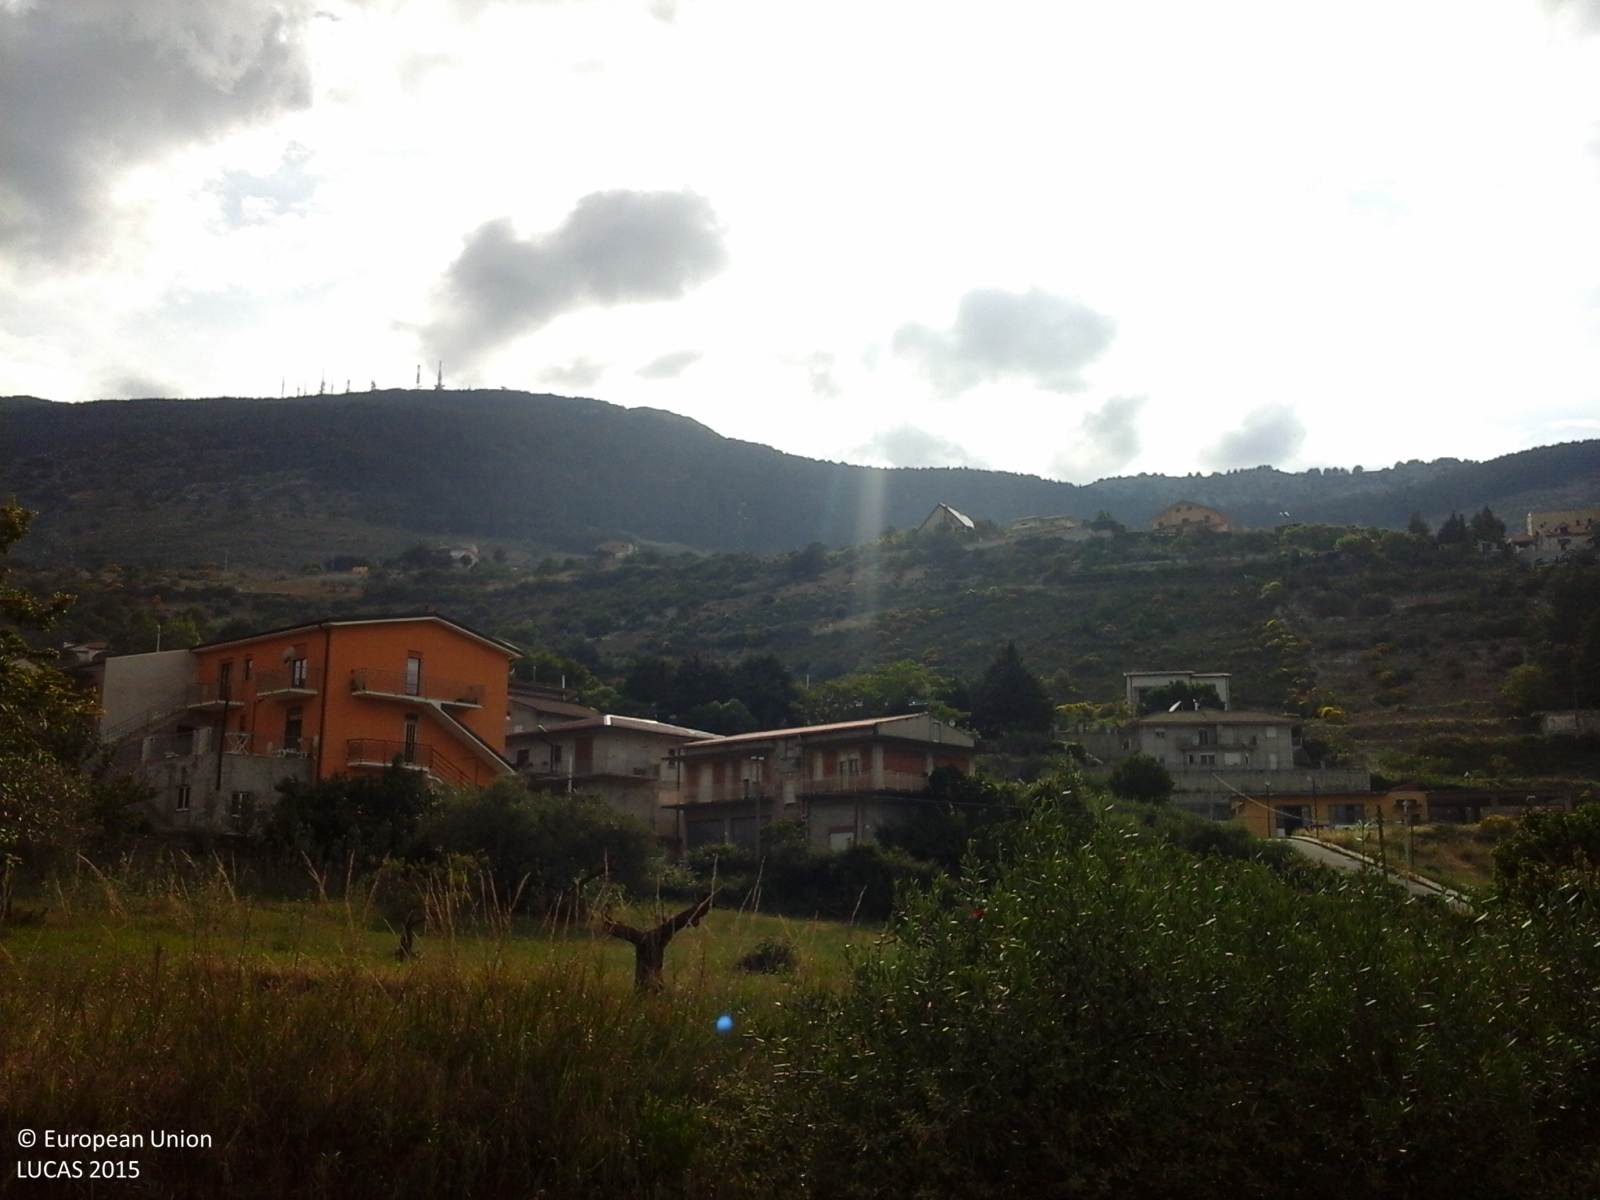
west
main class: Cropland
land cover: Olive groves
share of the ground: 50 - 75 %
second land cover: Other fresh vegetables
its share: > 75 %
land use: Agriculture (excluding fallow land and kitchen gardens)
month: June
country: IT
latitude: 37.6236
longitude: 13.6326
